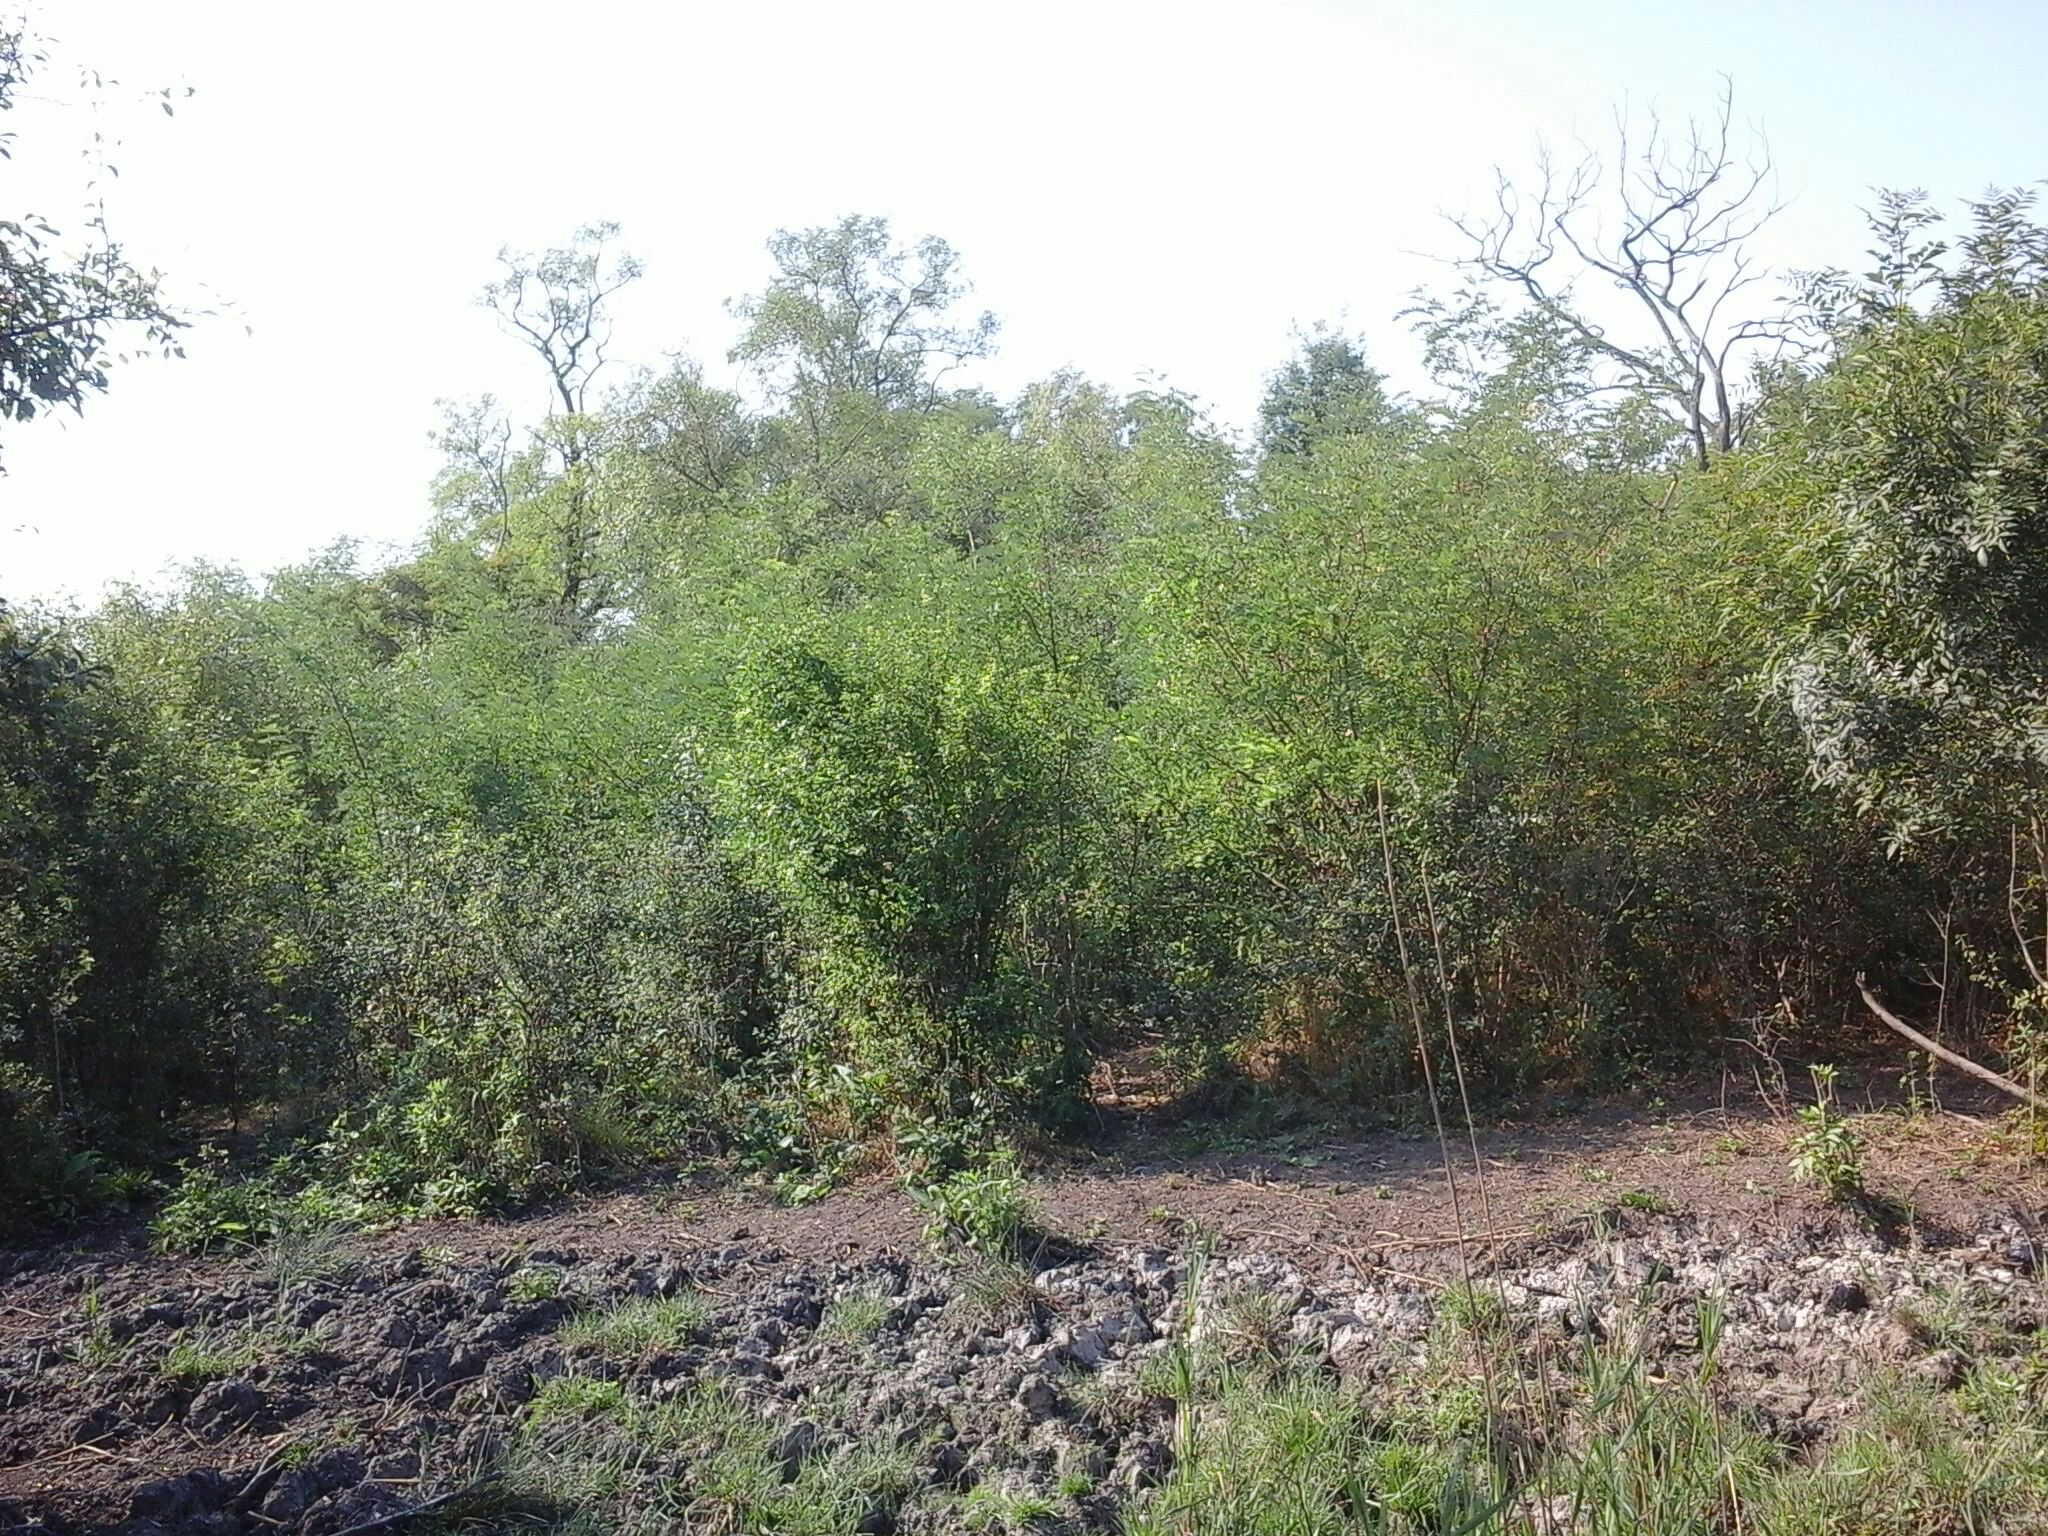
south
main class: Grassland
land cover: Grassland with sparse tree/shrub cover
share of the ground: > 75 %
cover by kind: herbaceous plants 70 %, unconsolidated bare surface 15 %, shrubs 10 %, broadleaved forest trees 5 %
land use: Agriculture (excluding fallow land and kitchen gardens)
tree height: > 5 m
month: August
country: HU
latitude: 47.1916
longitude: 18.2337
